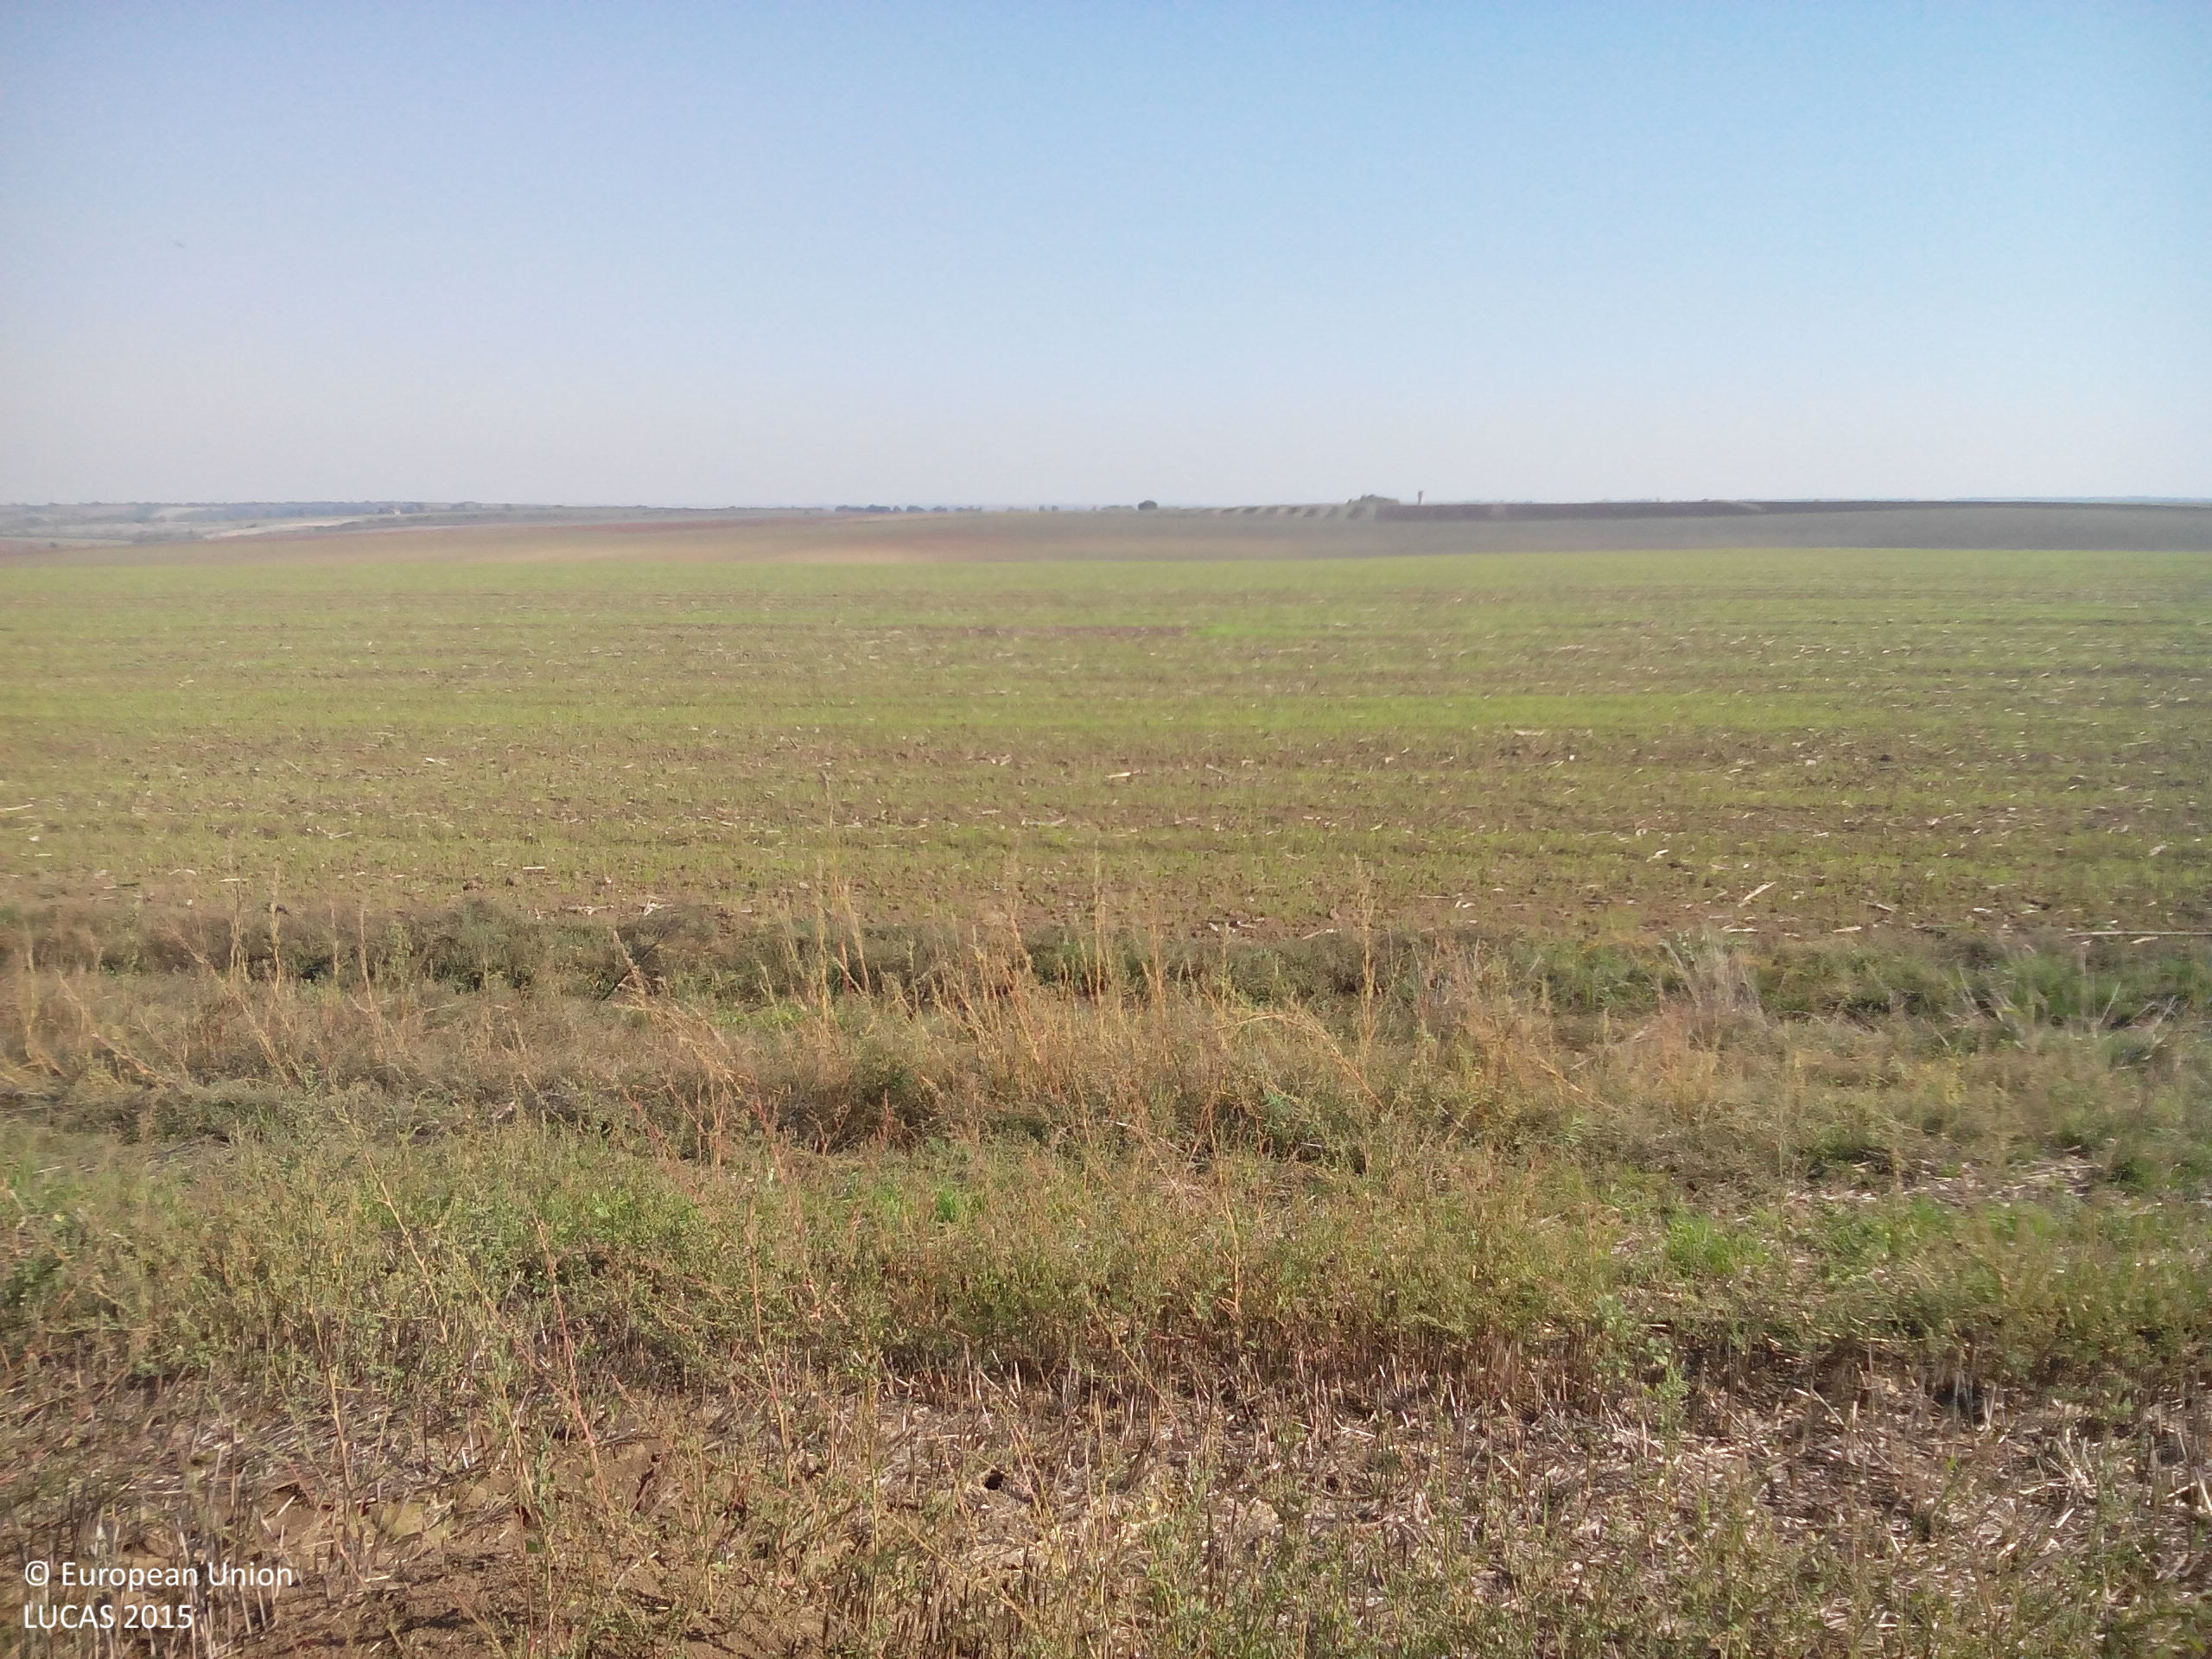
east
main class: Cropland
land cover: Common wheat
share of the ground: 10 - 25 %
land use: Agriculture (excluding fallow land and kitchen gardens)
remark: Harvested field
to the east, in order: Common wheat; Tracks; Maize
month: October
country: BG
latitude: 43.5499
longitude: 23.6757
